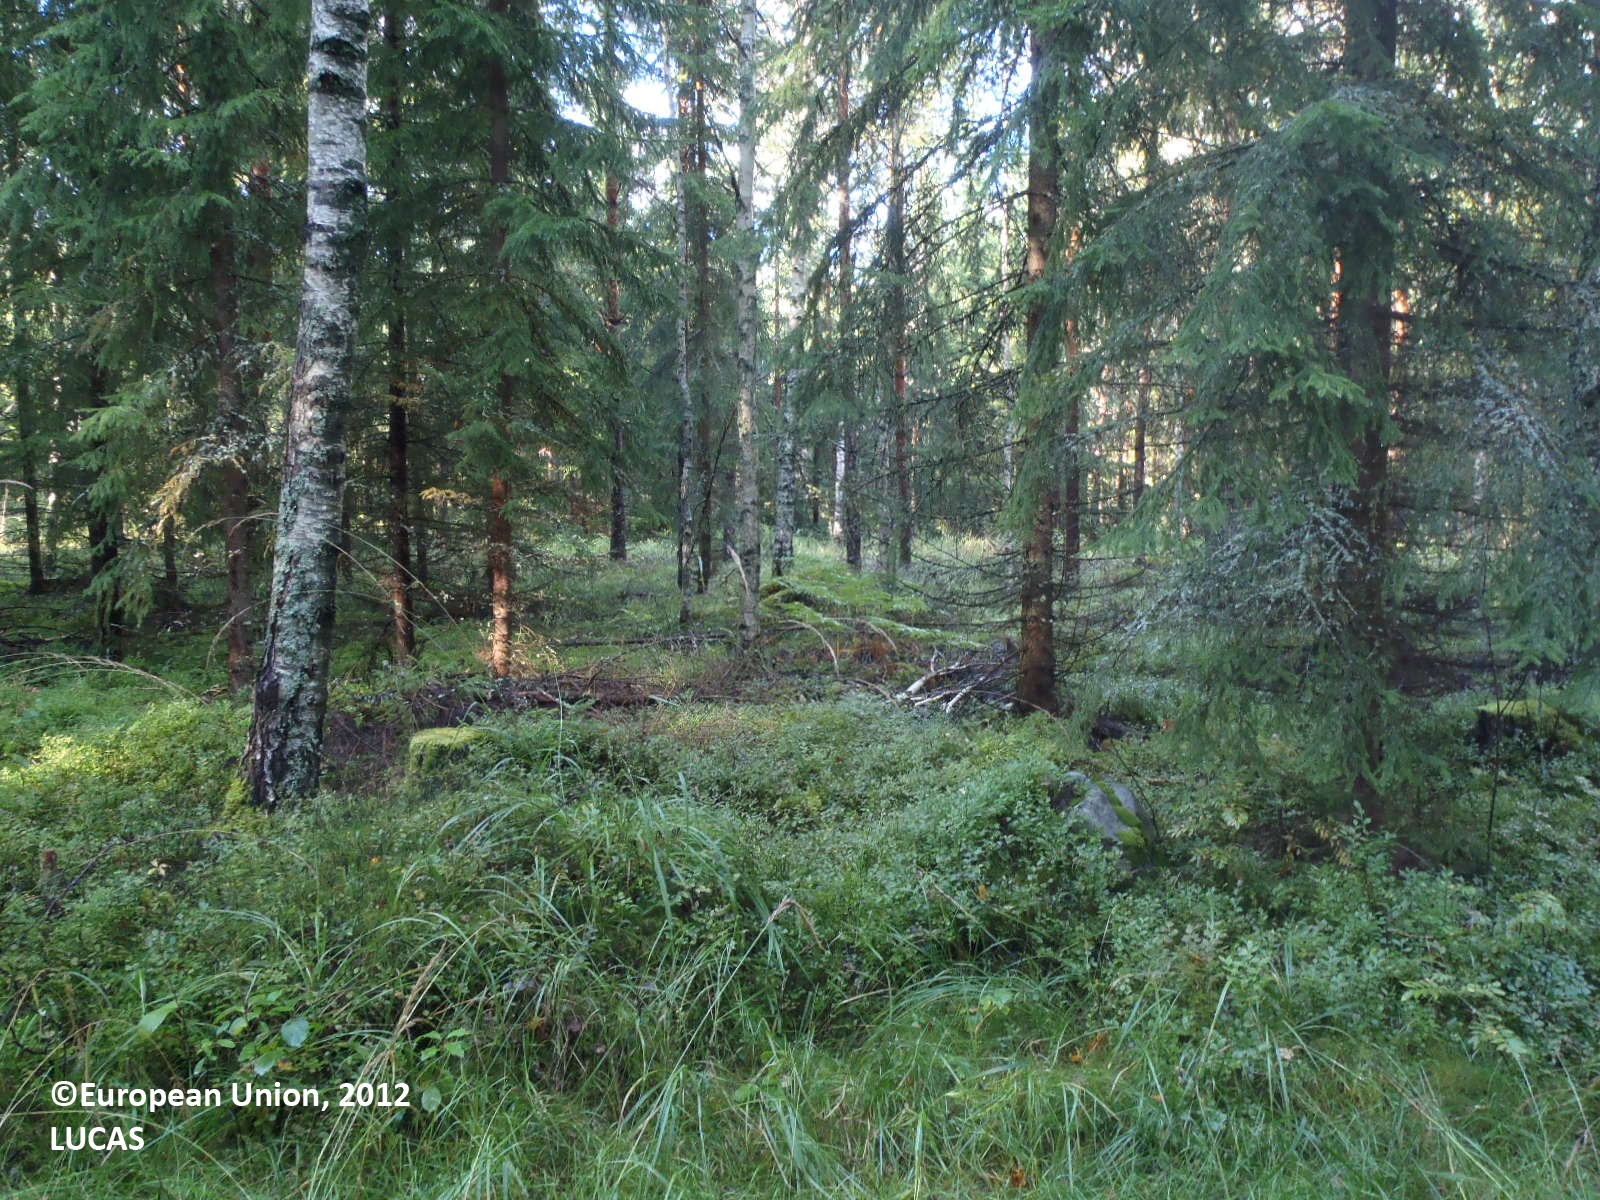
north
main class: Woodland
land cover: Pine dominated mixed woodland
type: boreal forest
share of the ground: > 75 %
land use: Forestry
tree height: > 5 m
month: September
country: FI
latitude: 61.0909
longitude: 22.6223
